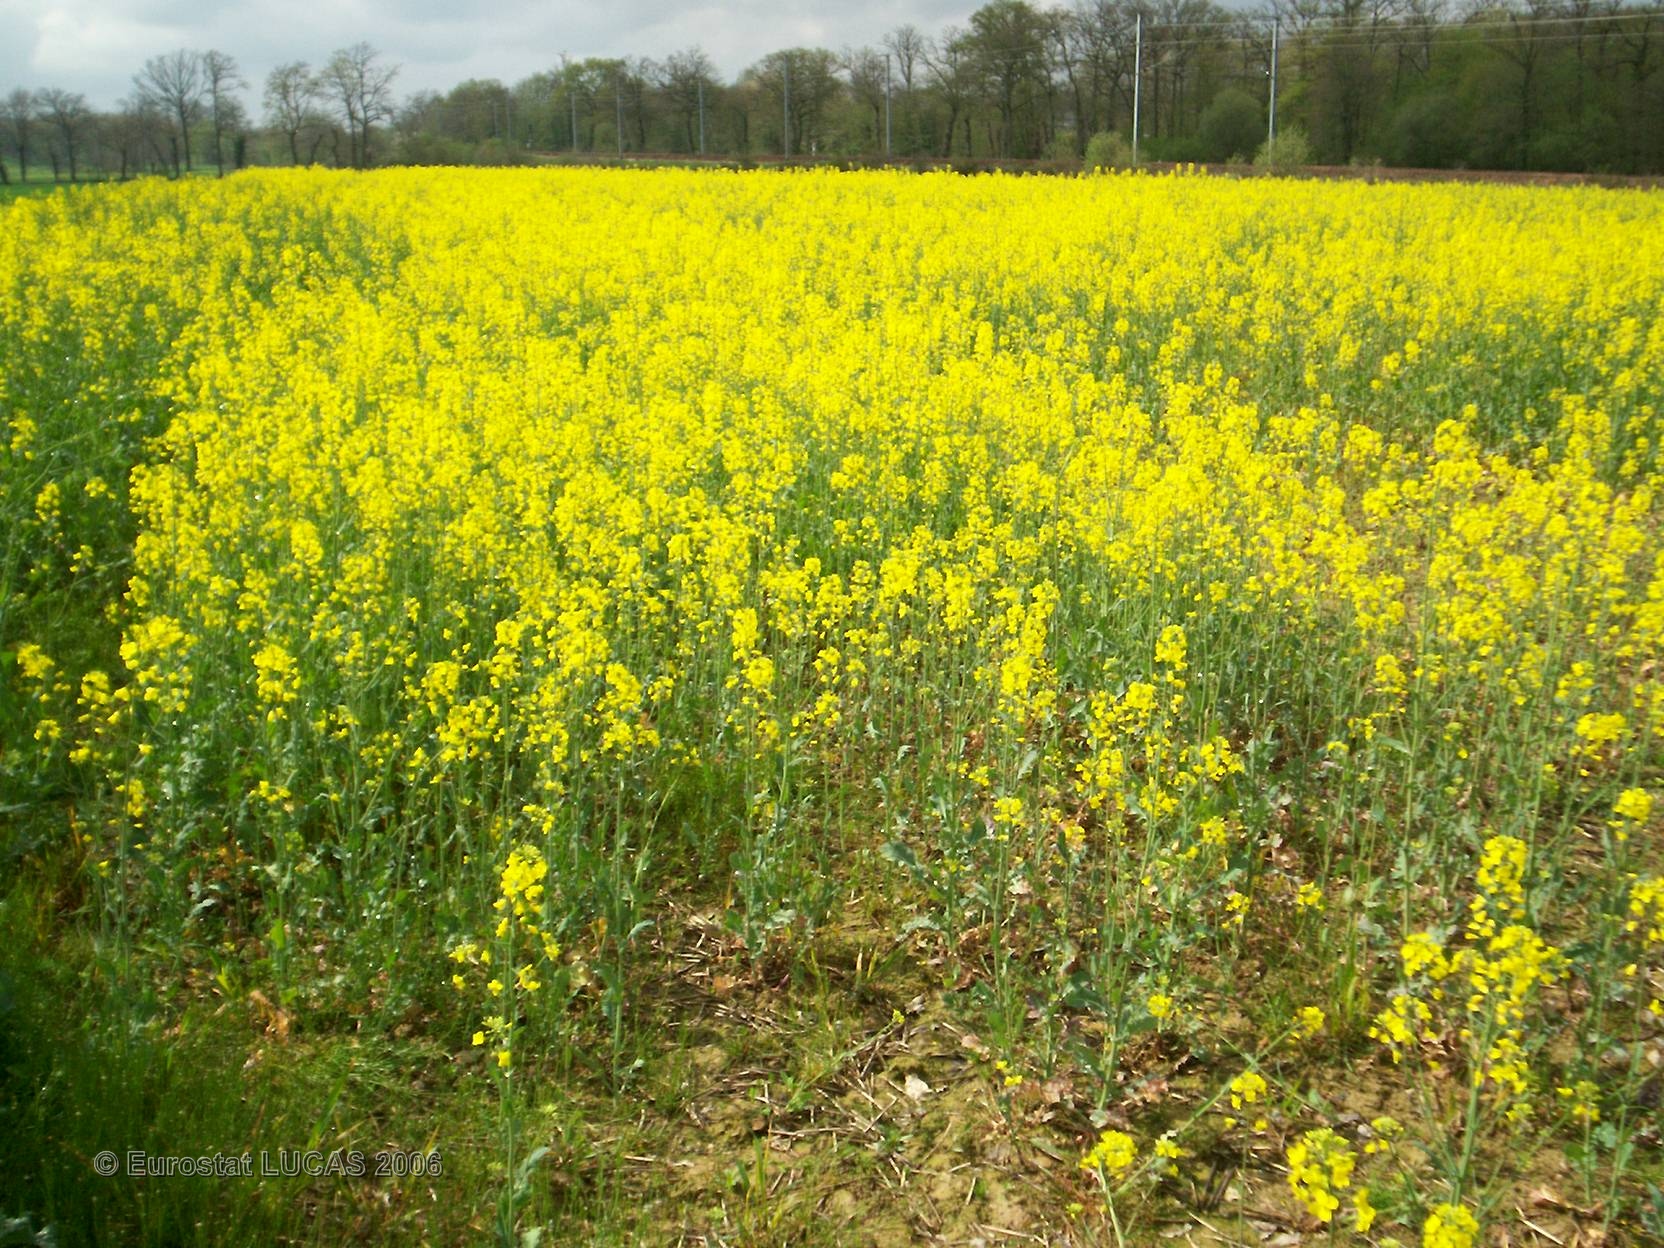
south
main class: Cropland
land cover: Rape and turnip rape
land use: Agriculture (excluding fallow land and kitchen gardens)
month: April
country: FR
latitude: 48.2229
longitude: -1.6374
